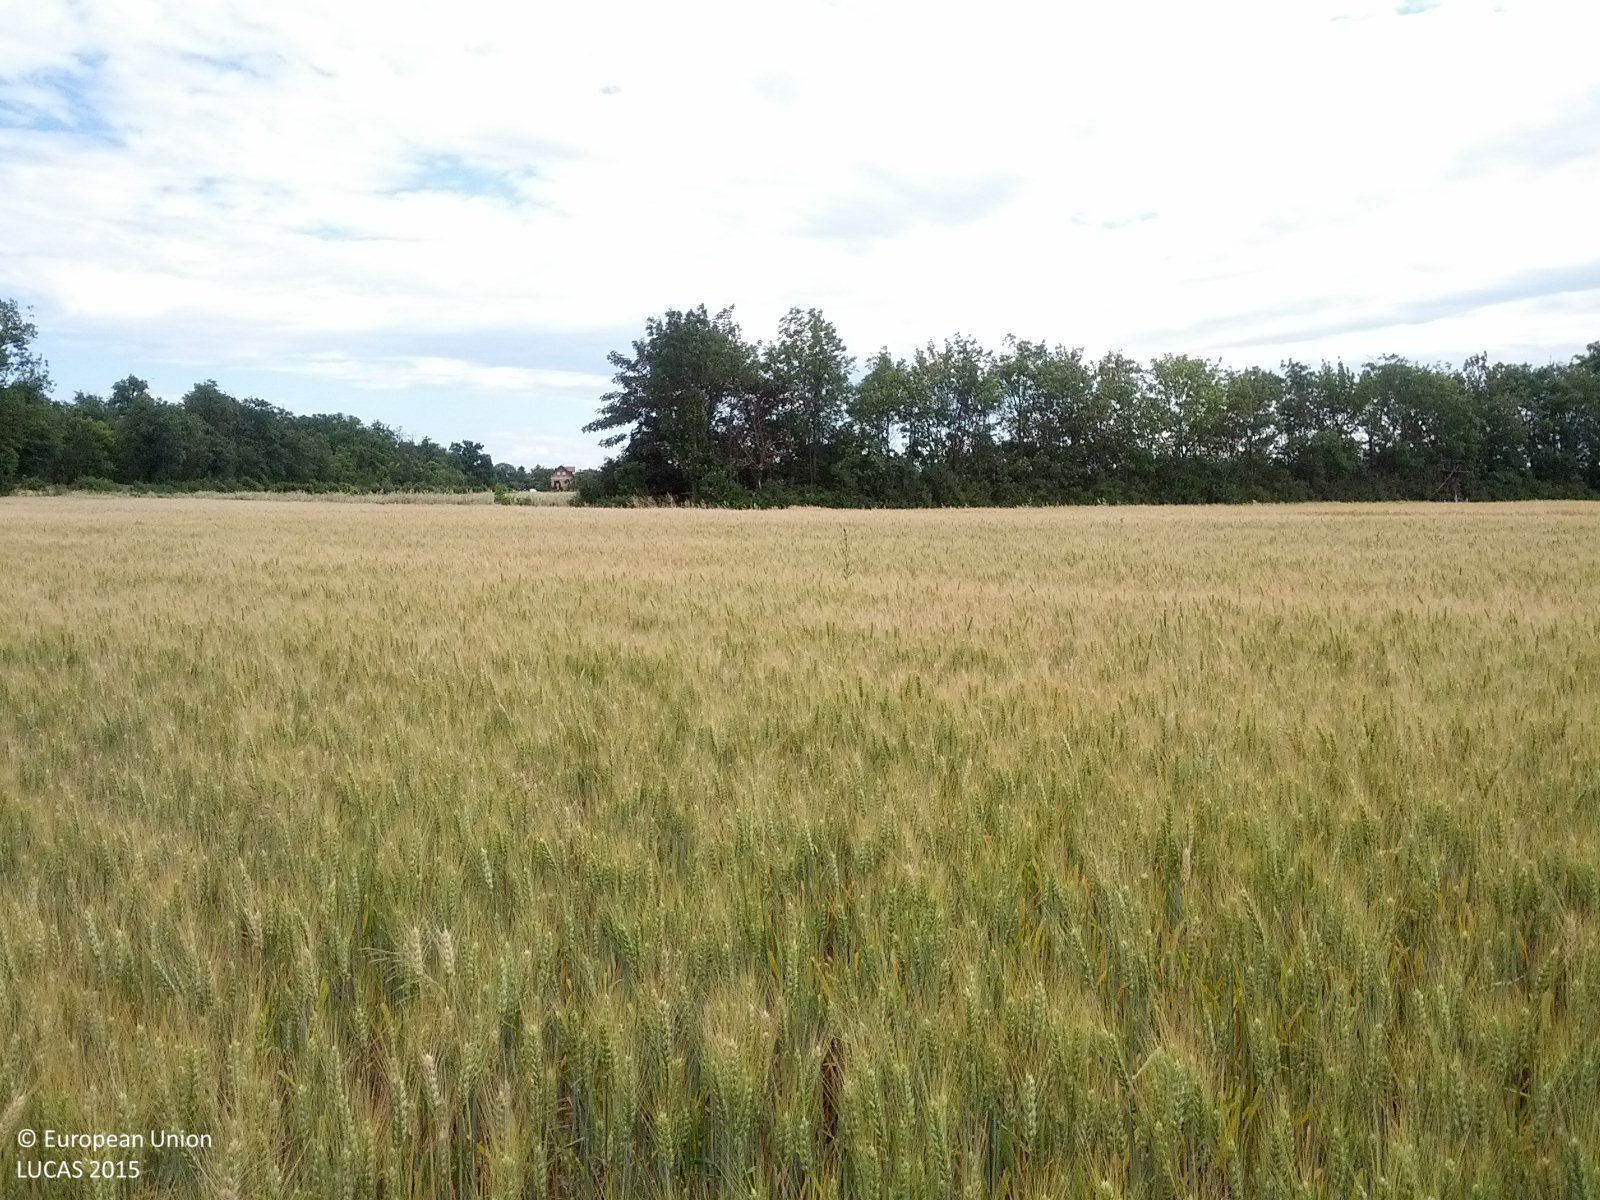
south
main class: Cropland
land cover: Durum wheat
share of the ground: > 75 %
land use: Agriculture (excluding fallow land and kitchen gardens)
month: June
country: AT
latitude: 48.2723
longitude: 16.7027
